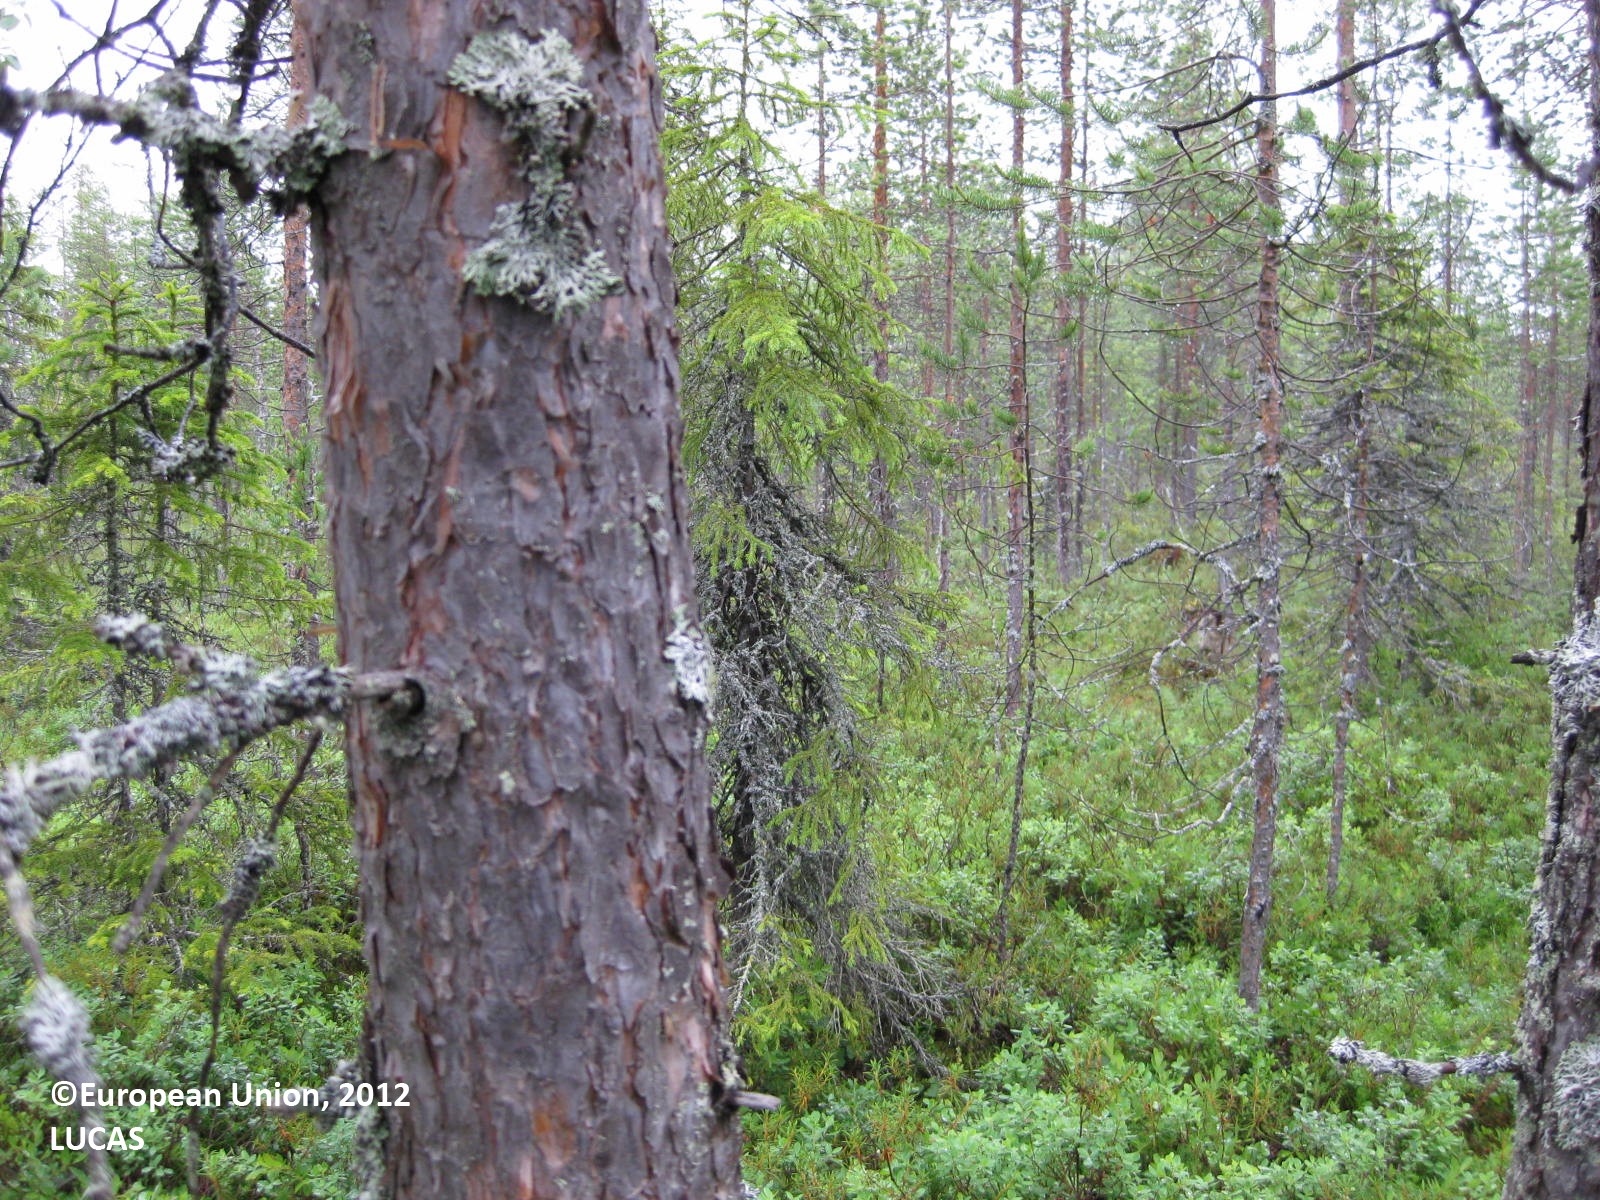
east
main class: Woodland
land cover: Pine dominated coniferous woodland
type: boreal forest
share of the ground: > 75 %
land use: Forestry
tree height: > 5 m
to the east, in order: Pine dominated coniferous woodland; Ditches and canals; Pine dominated coniferous woodland
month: July
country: FI
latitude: 65.6216
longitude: 28.4168
